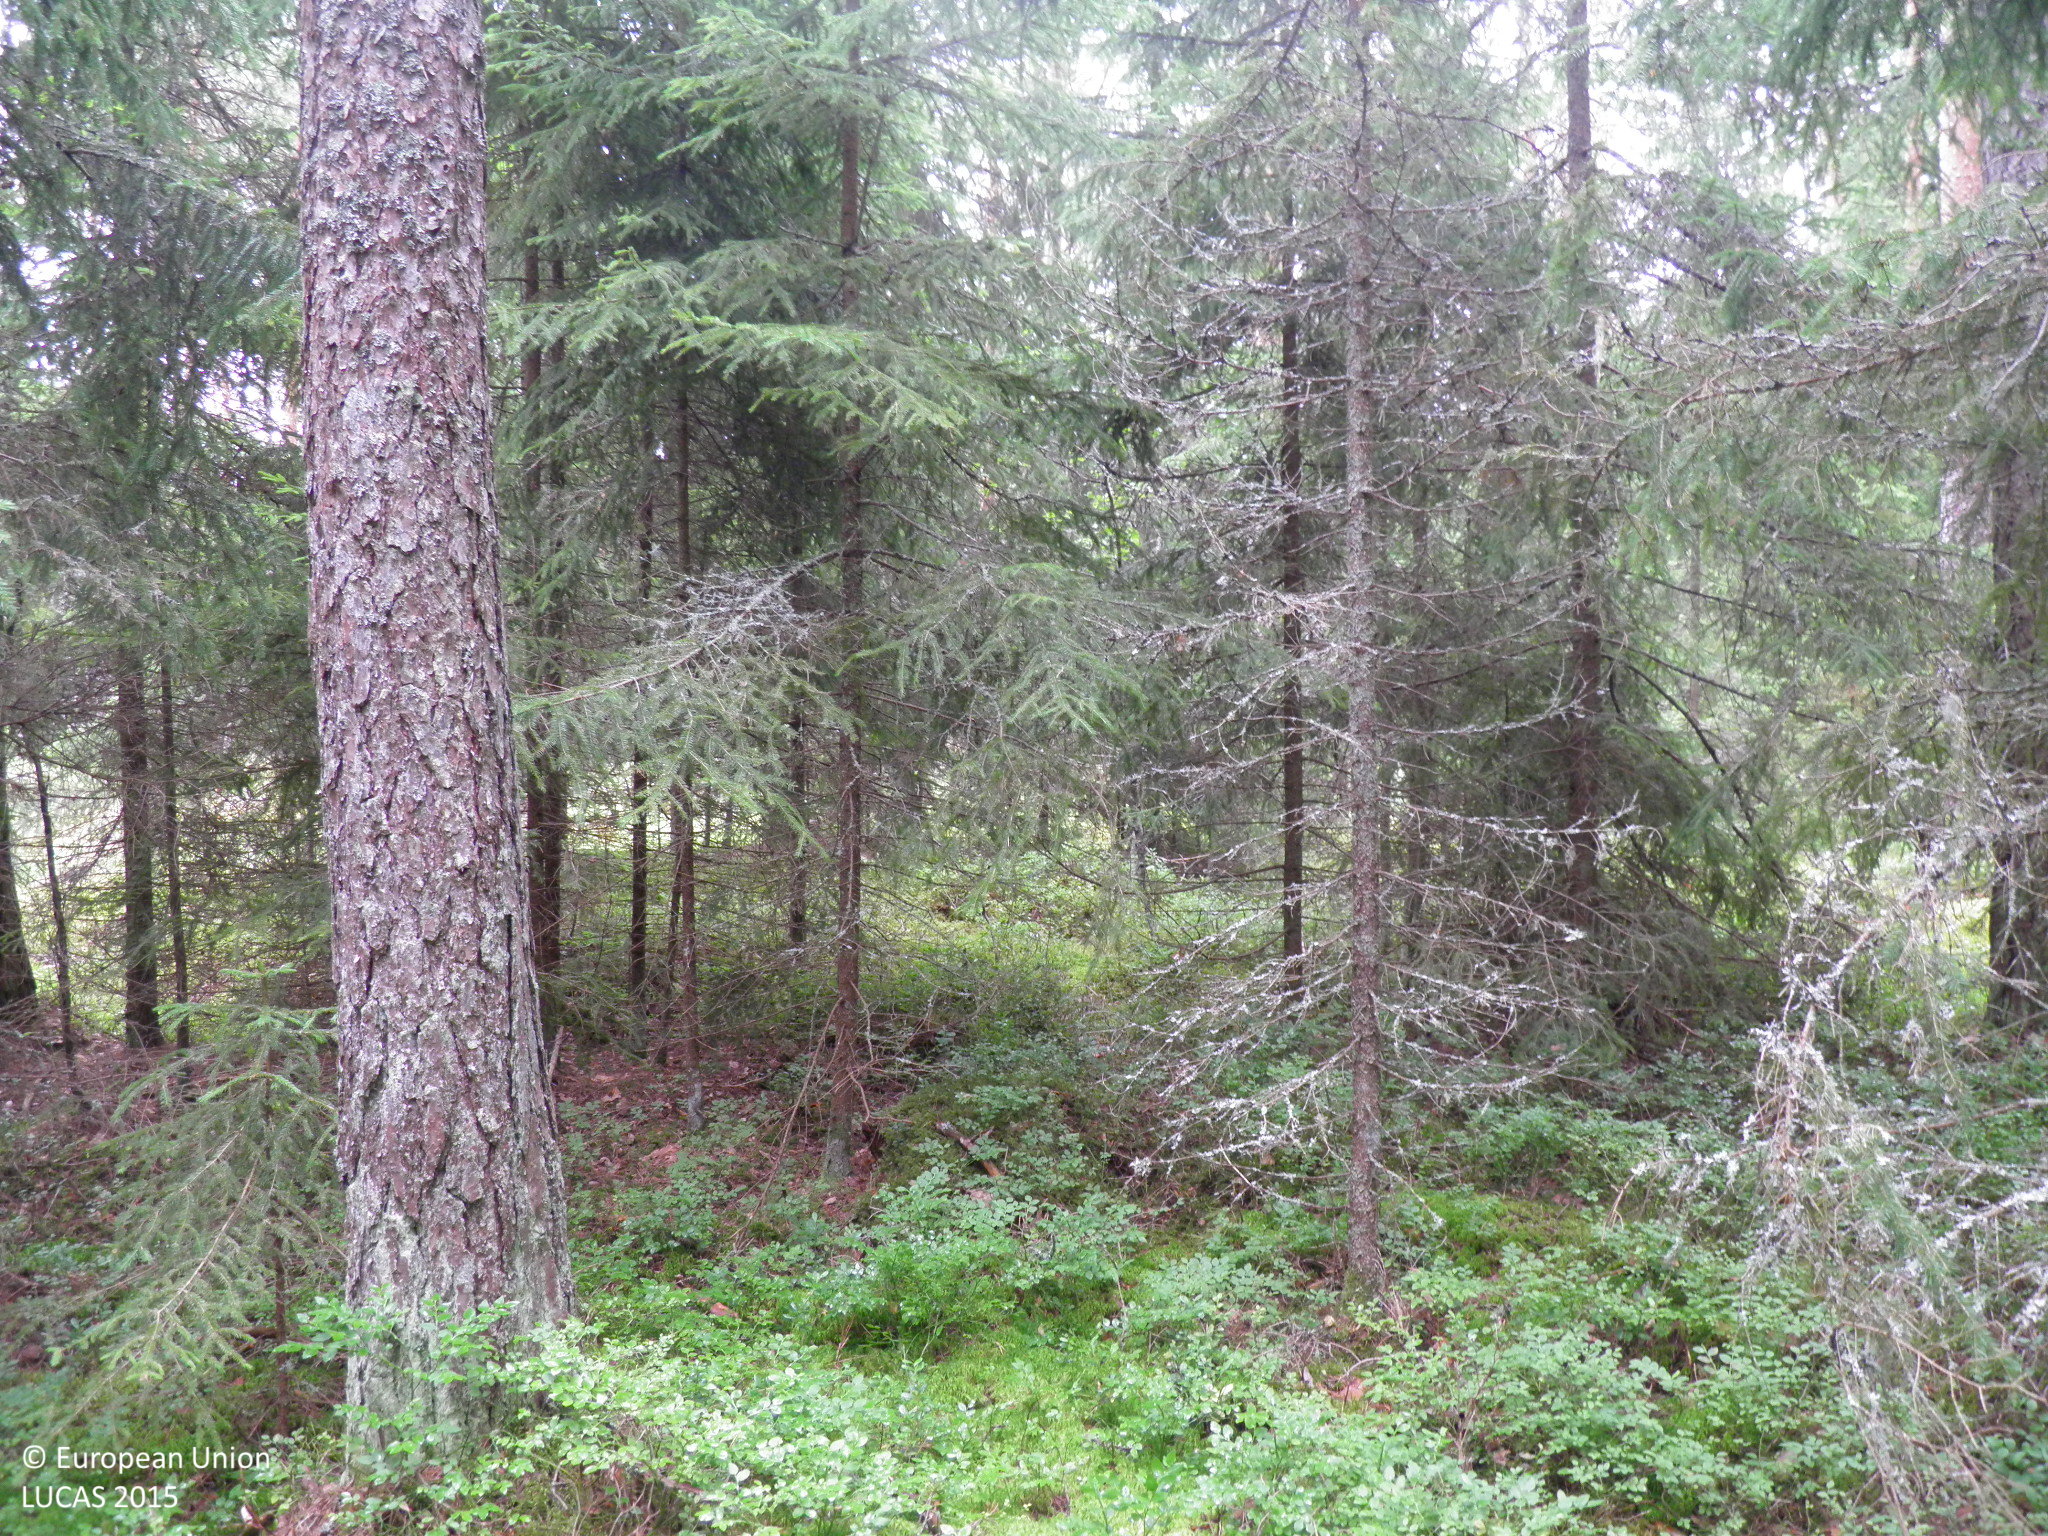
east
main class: Woodland
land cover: Pine dominated coniferous woodland
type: hemiboreal forest and nemoral coniferous forest and mixed broadleaved-coniferous forest
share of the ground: 50 - 75 %
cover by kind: coniferous forest trees 50 %, shrubs 30 %, broadleaved forest trees 10 %, lichens and mosses 10 %
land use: Forestry
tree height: > 5 m
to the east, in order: Pine dominated coniferous woodland; Spruce dominated coniferous woodland; Ditches and canals; Spruce dominated coniferous woodland; Ditches and canals; Tracks; Grass margins; Ditches and canals; Barley
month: July
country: FI
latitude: 60.6216
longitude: 21.4769
